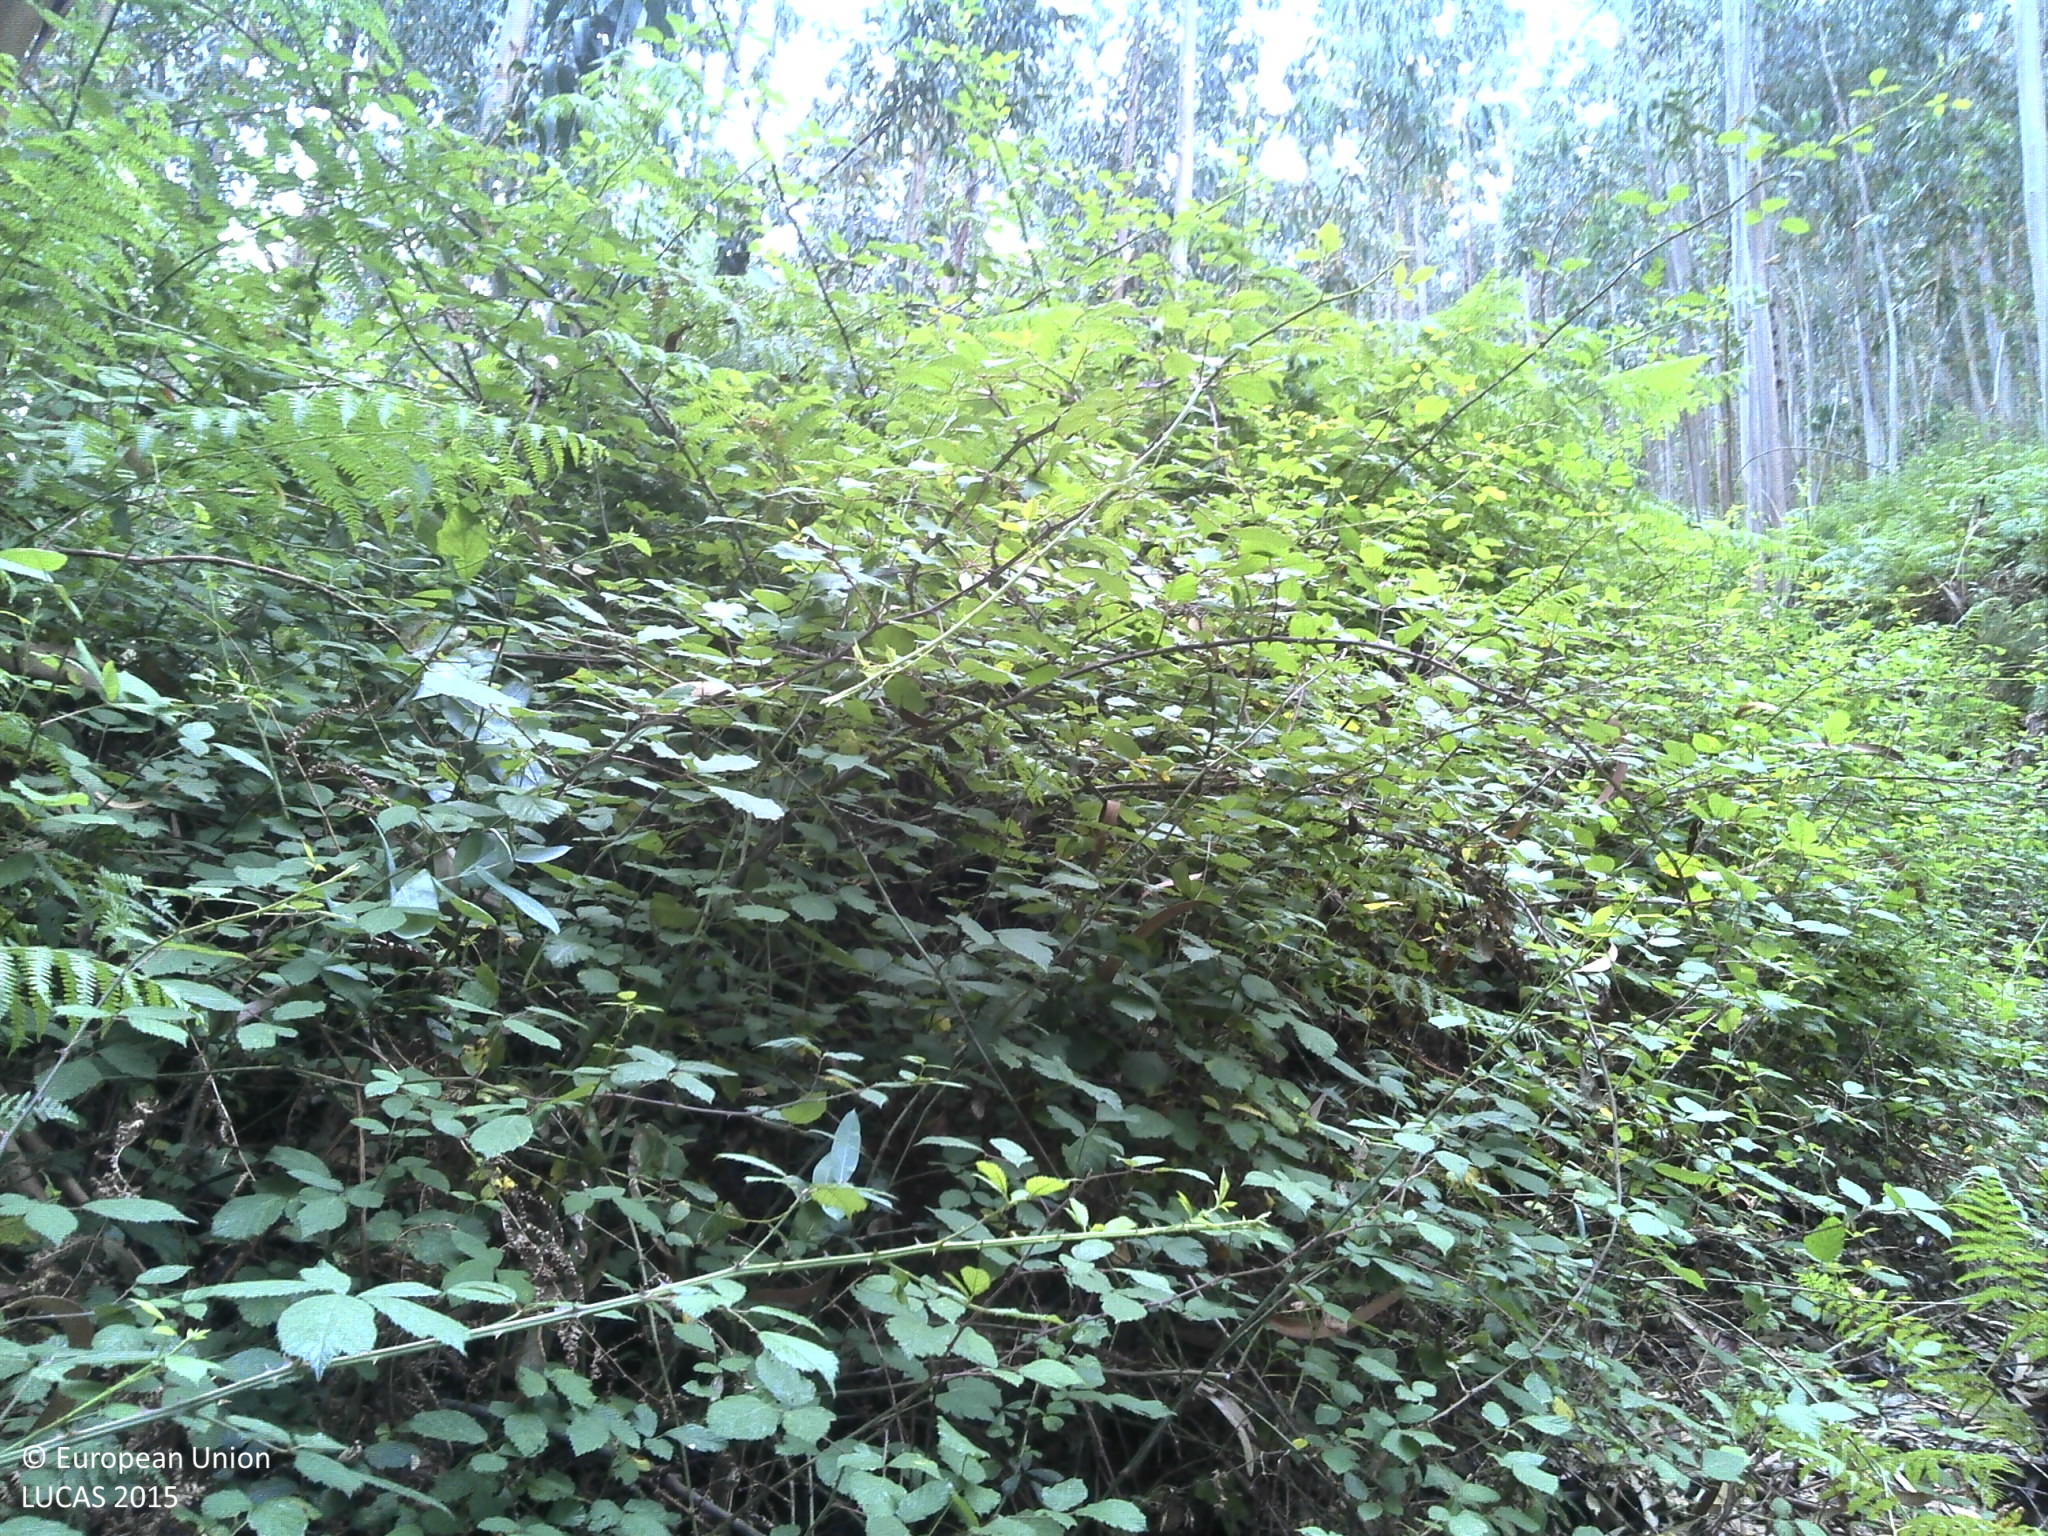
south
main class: Woodland
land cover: Broadleaved woodland
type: exotic forest
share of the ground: 50 - 75 %
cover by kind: broadleaved forest trees 70 %, shrubs 25 %, unconsolidated bare surface 5 %
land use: Forestry
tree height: > 5 m
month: June
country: PT
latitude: 40.3471
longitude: -8.3679
